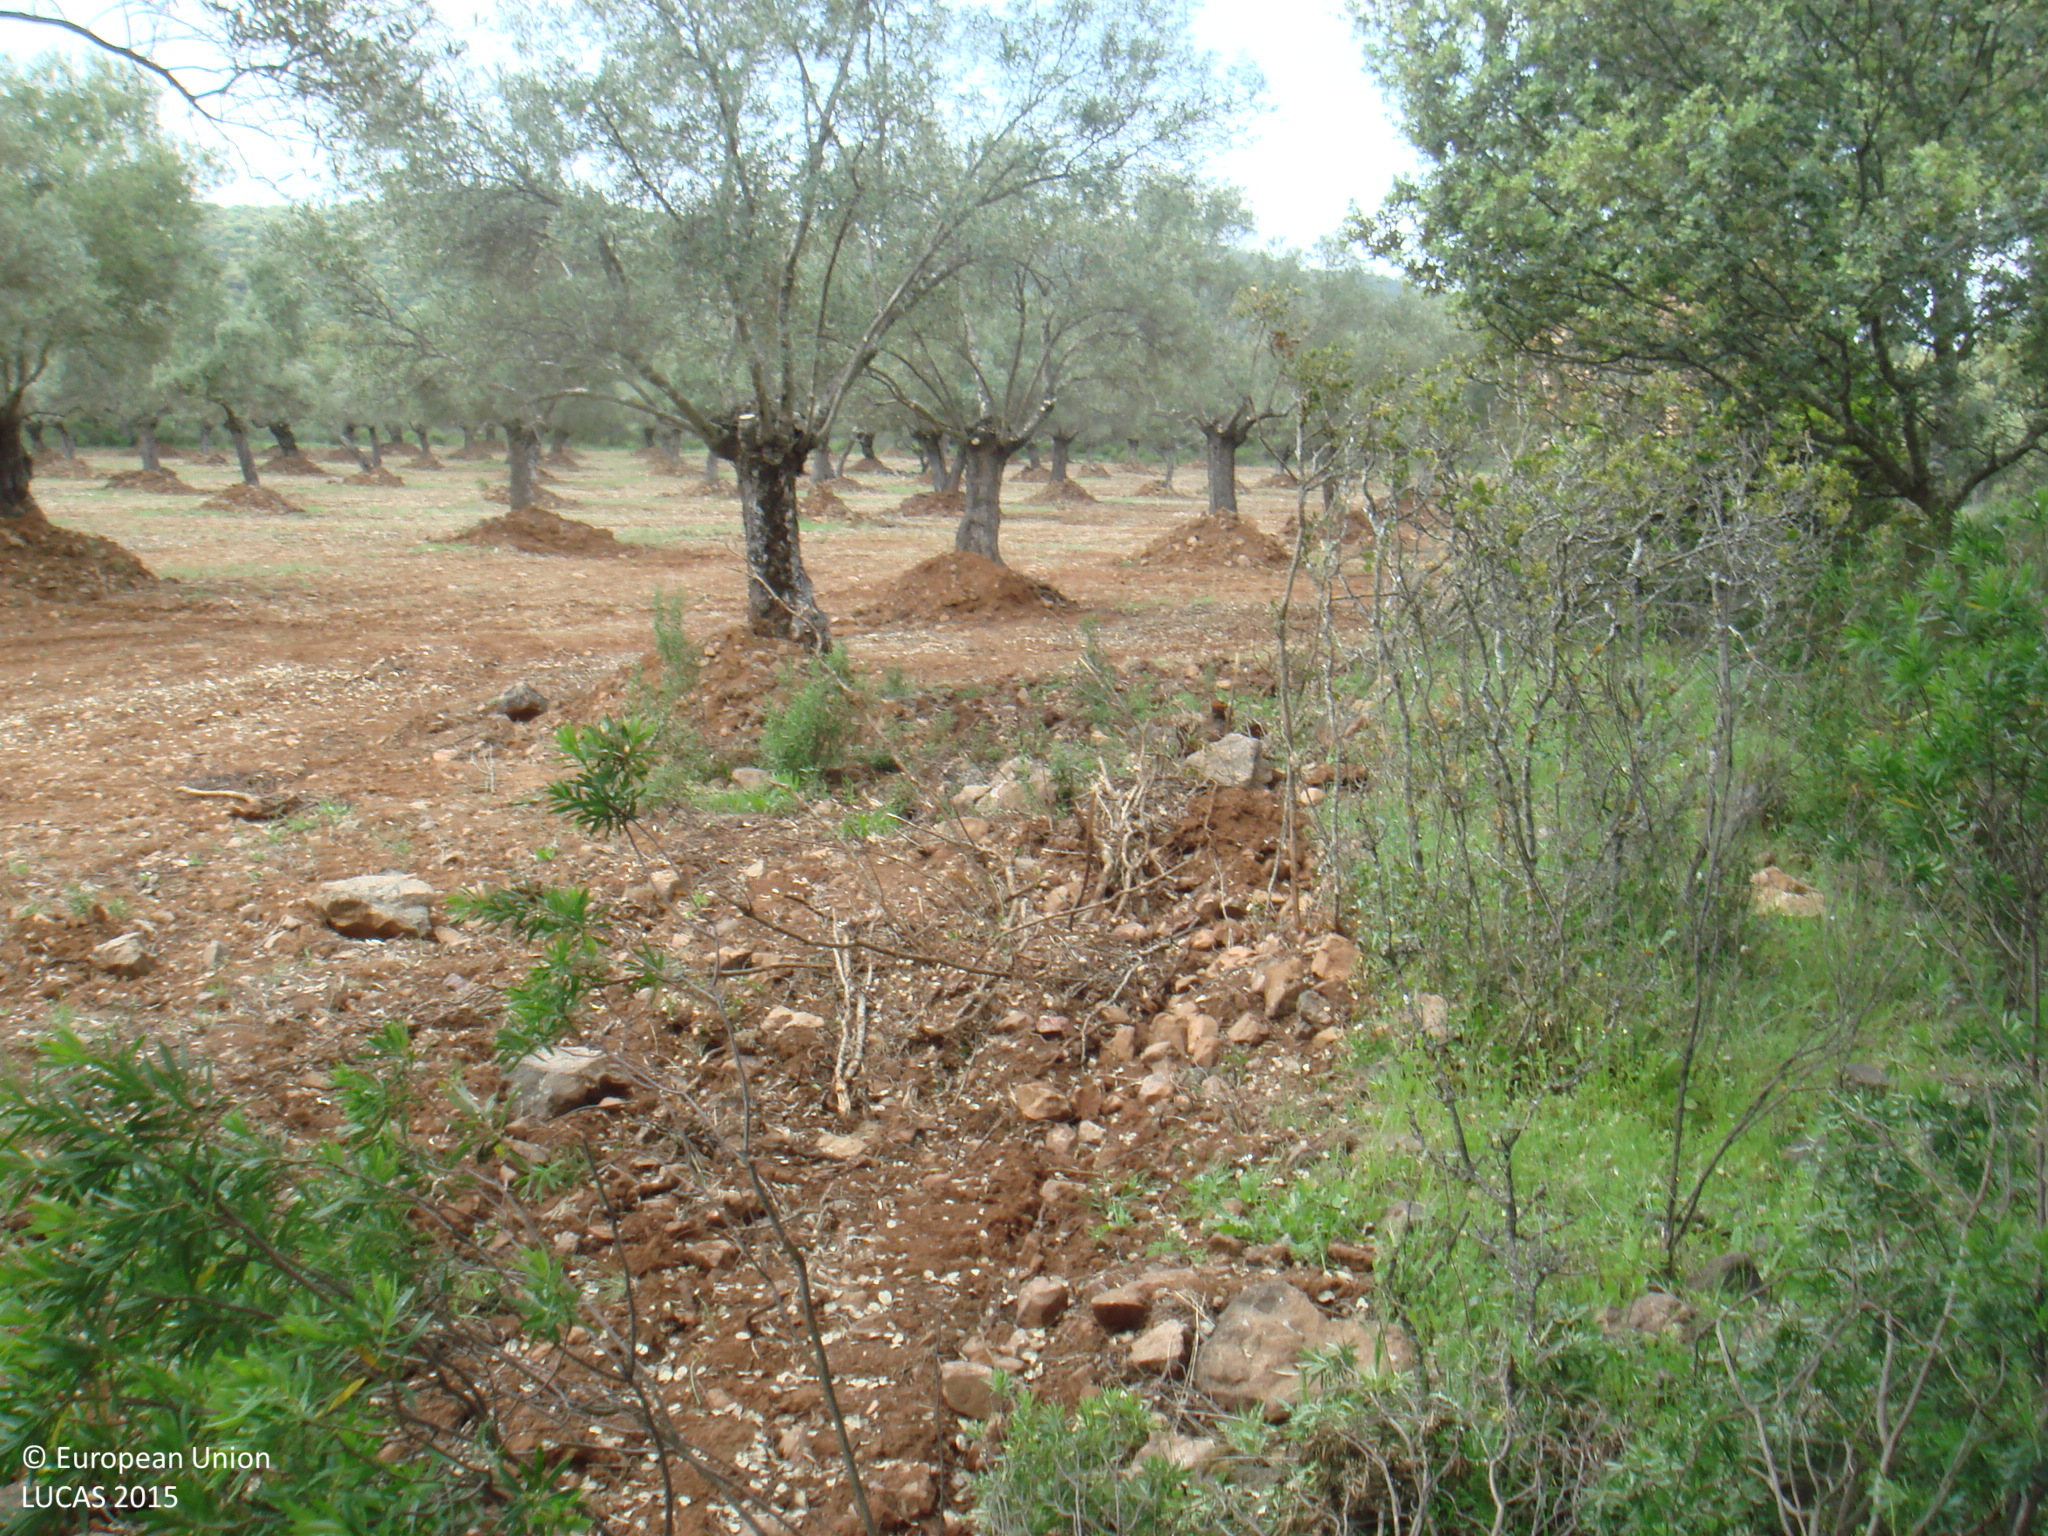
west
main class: Woodland
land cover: Broadleaved woodland
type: broadleaved evergreen forest
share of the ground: 25 - 50 %
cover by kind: broadleaved forest trees 40 %, shrubs 30 %, herbaceous plants 30 %
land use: Forestry
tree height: < 5 m
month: April
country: ES
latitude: 38.2639
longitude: -5.1002
